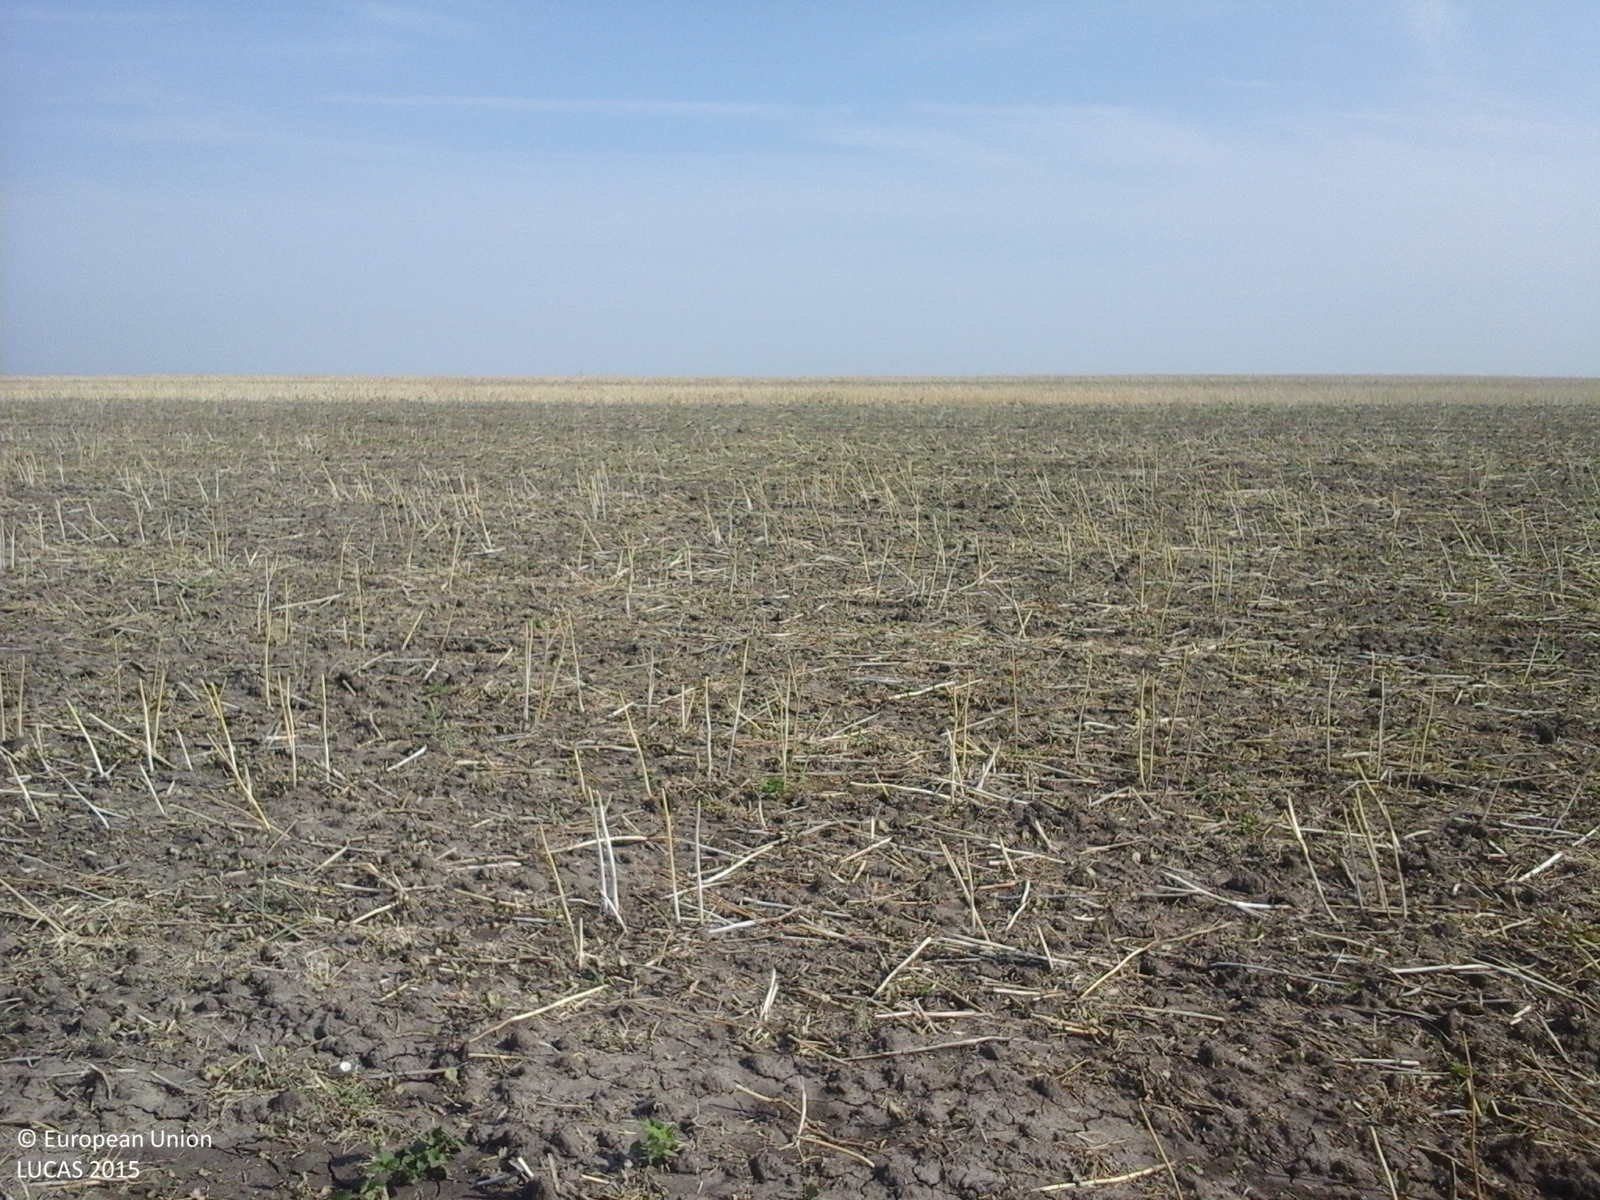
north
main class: Cropland
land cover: Rape and turnip rape
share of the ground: 10 - 25 %
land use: Agriculture (excluding fallow land and kitchen gardens)
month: August
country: RO
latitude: 44.2308
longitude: 23.0773
